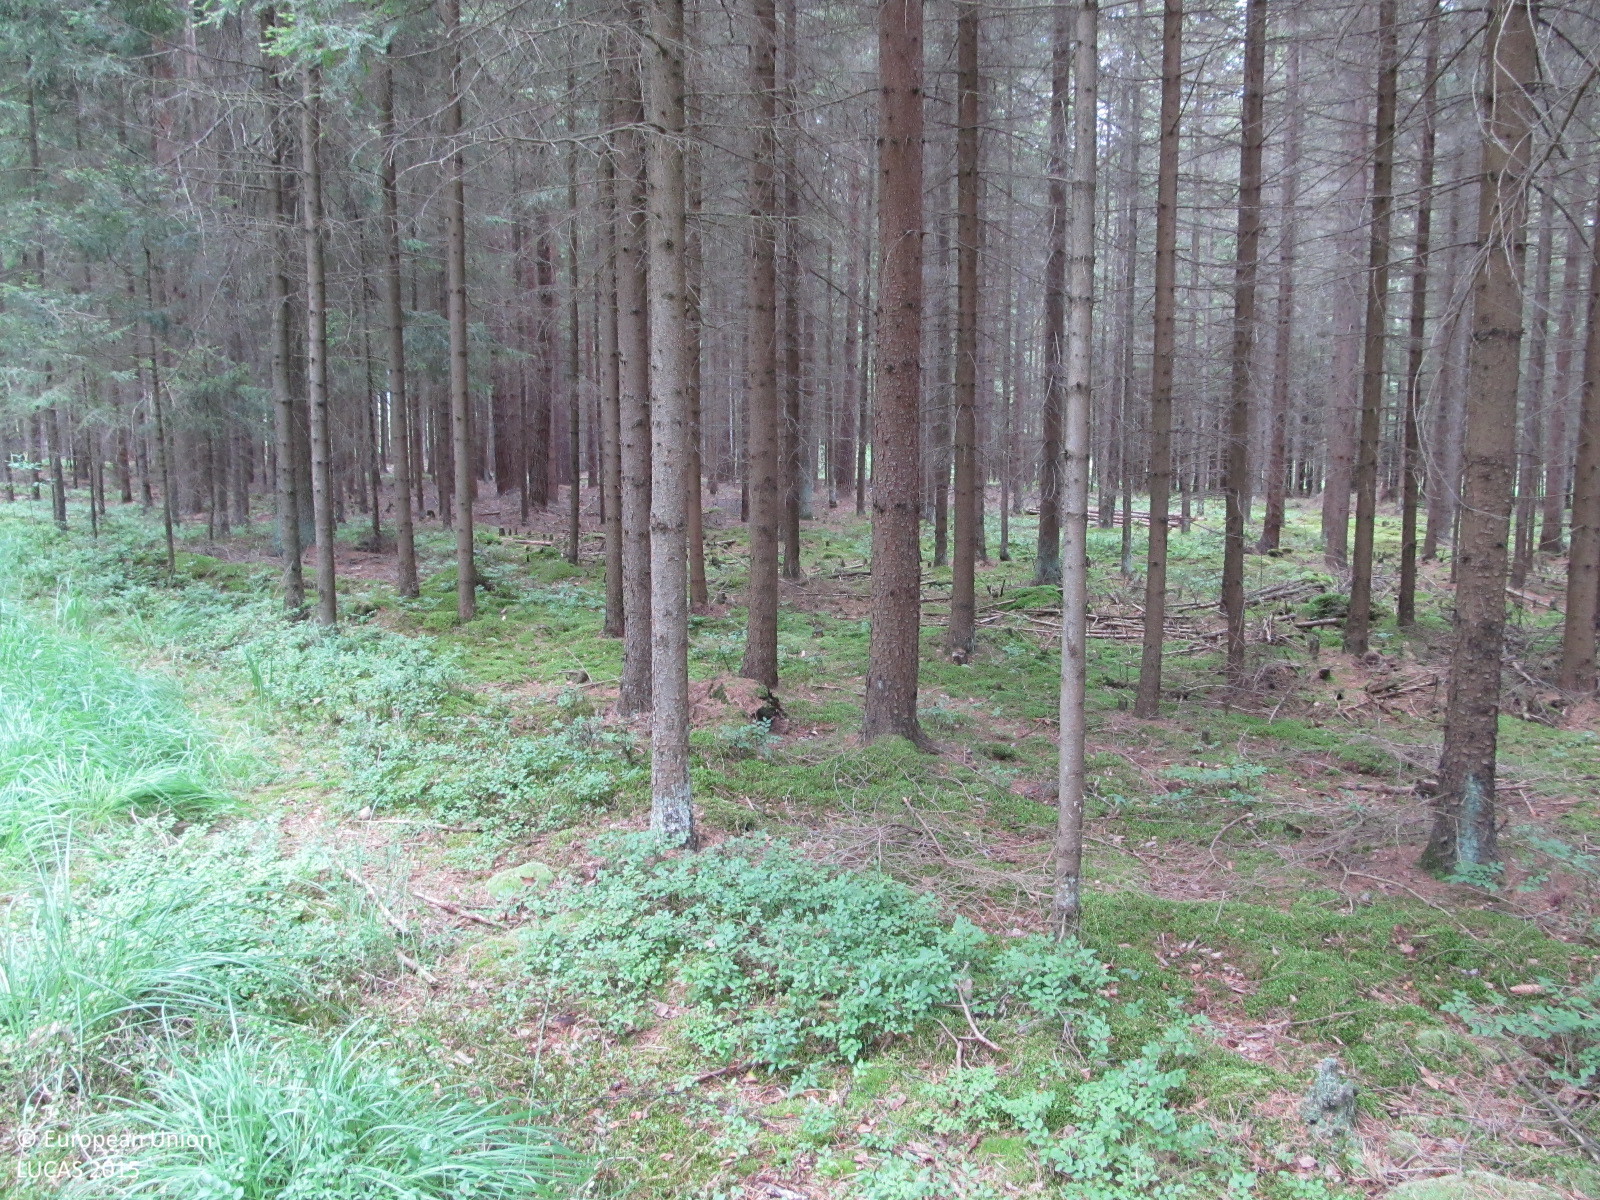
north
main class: Woodland
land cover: Spruce dominated coniferous woodland
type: hemiboreal forest and nemoral coniferous forest and mixed broadleaved-coniferous forest
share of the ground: > 75 %
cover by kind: coniferous forest trees 85 %, shrubs 5 %, herbaceous plants 5 %, lichens and mosses 5 %
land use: Forestry
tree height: > 5 m
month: July
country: AT
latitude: 48.7581
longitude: 15.0214
